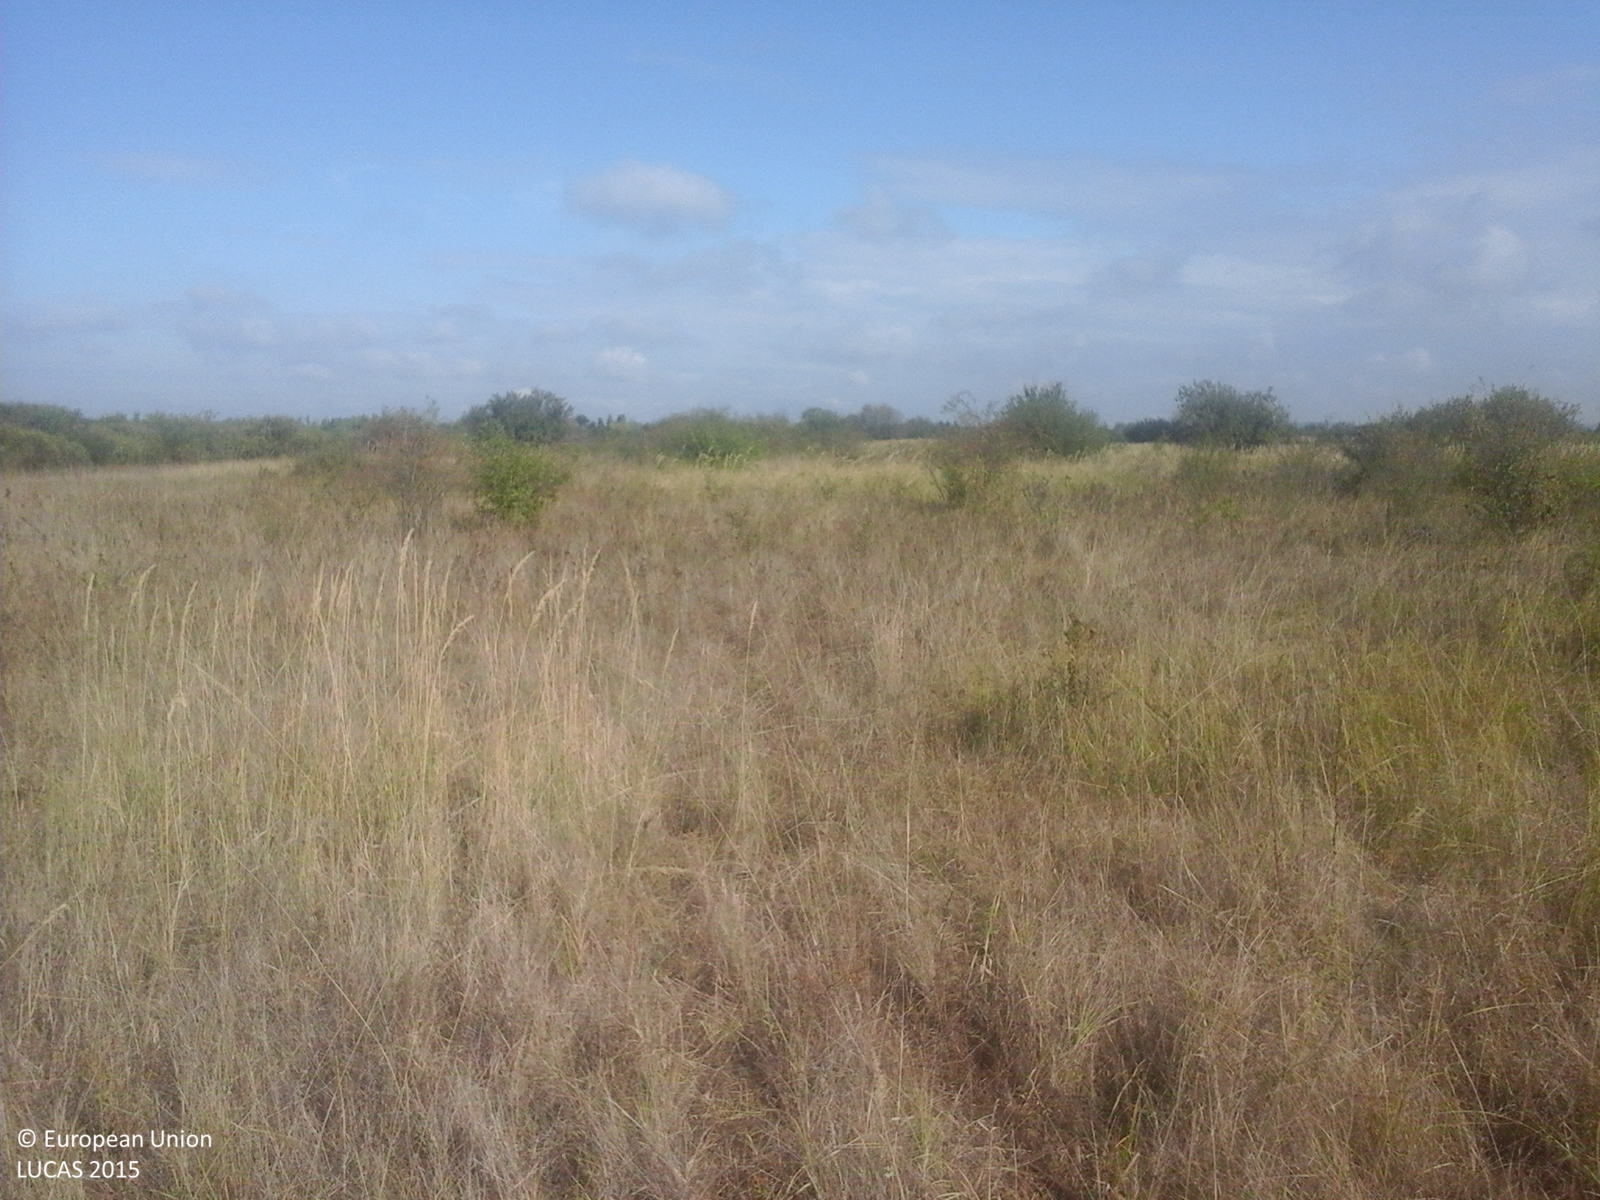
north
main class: Grassland
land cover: Spontaneously vegetated surfaces
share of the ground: > 75 %
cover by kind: herbaceous plants 100 %
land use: Fallow land
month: September
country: RO
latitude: 47.9226
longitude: 23.0085
